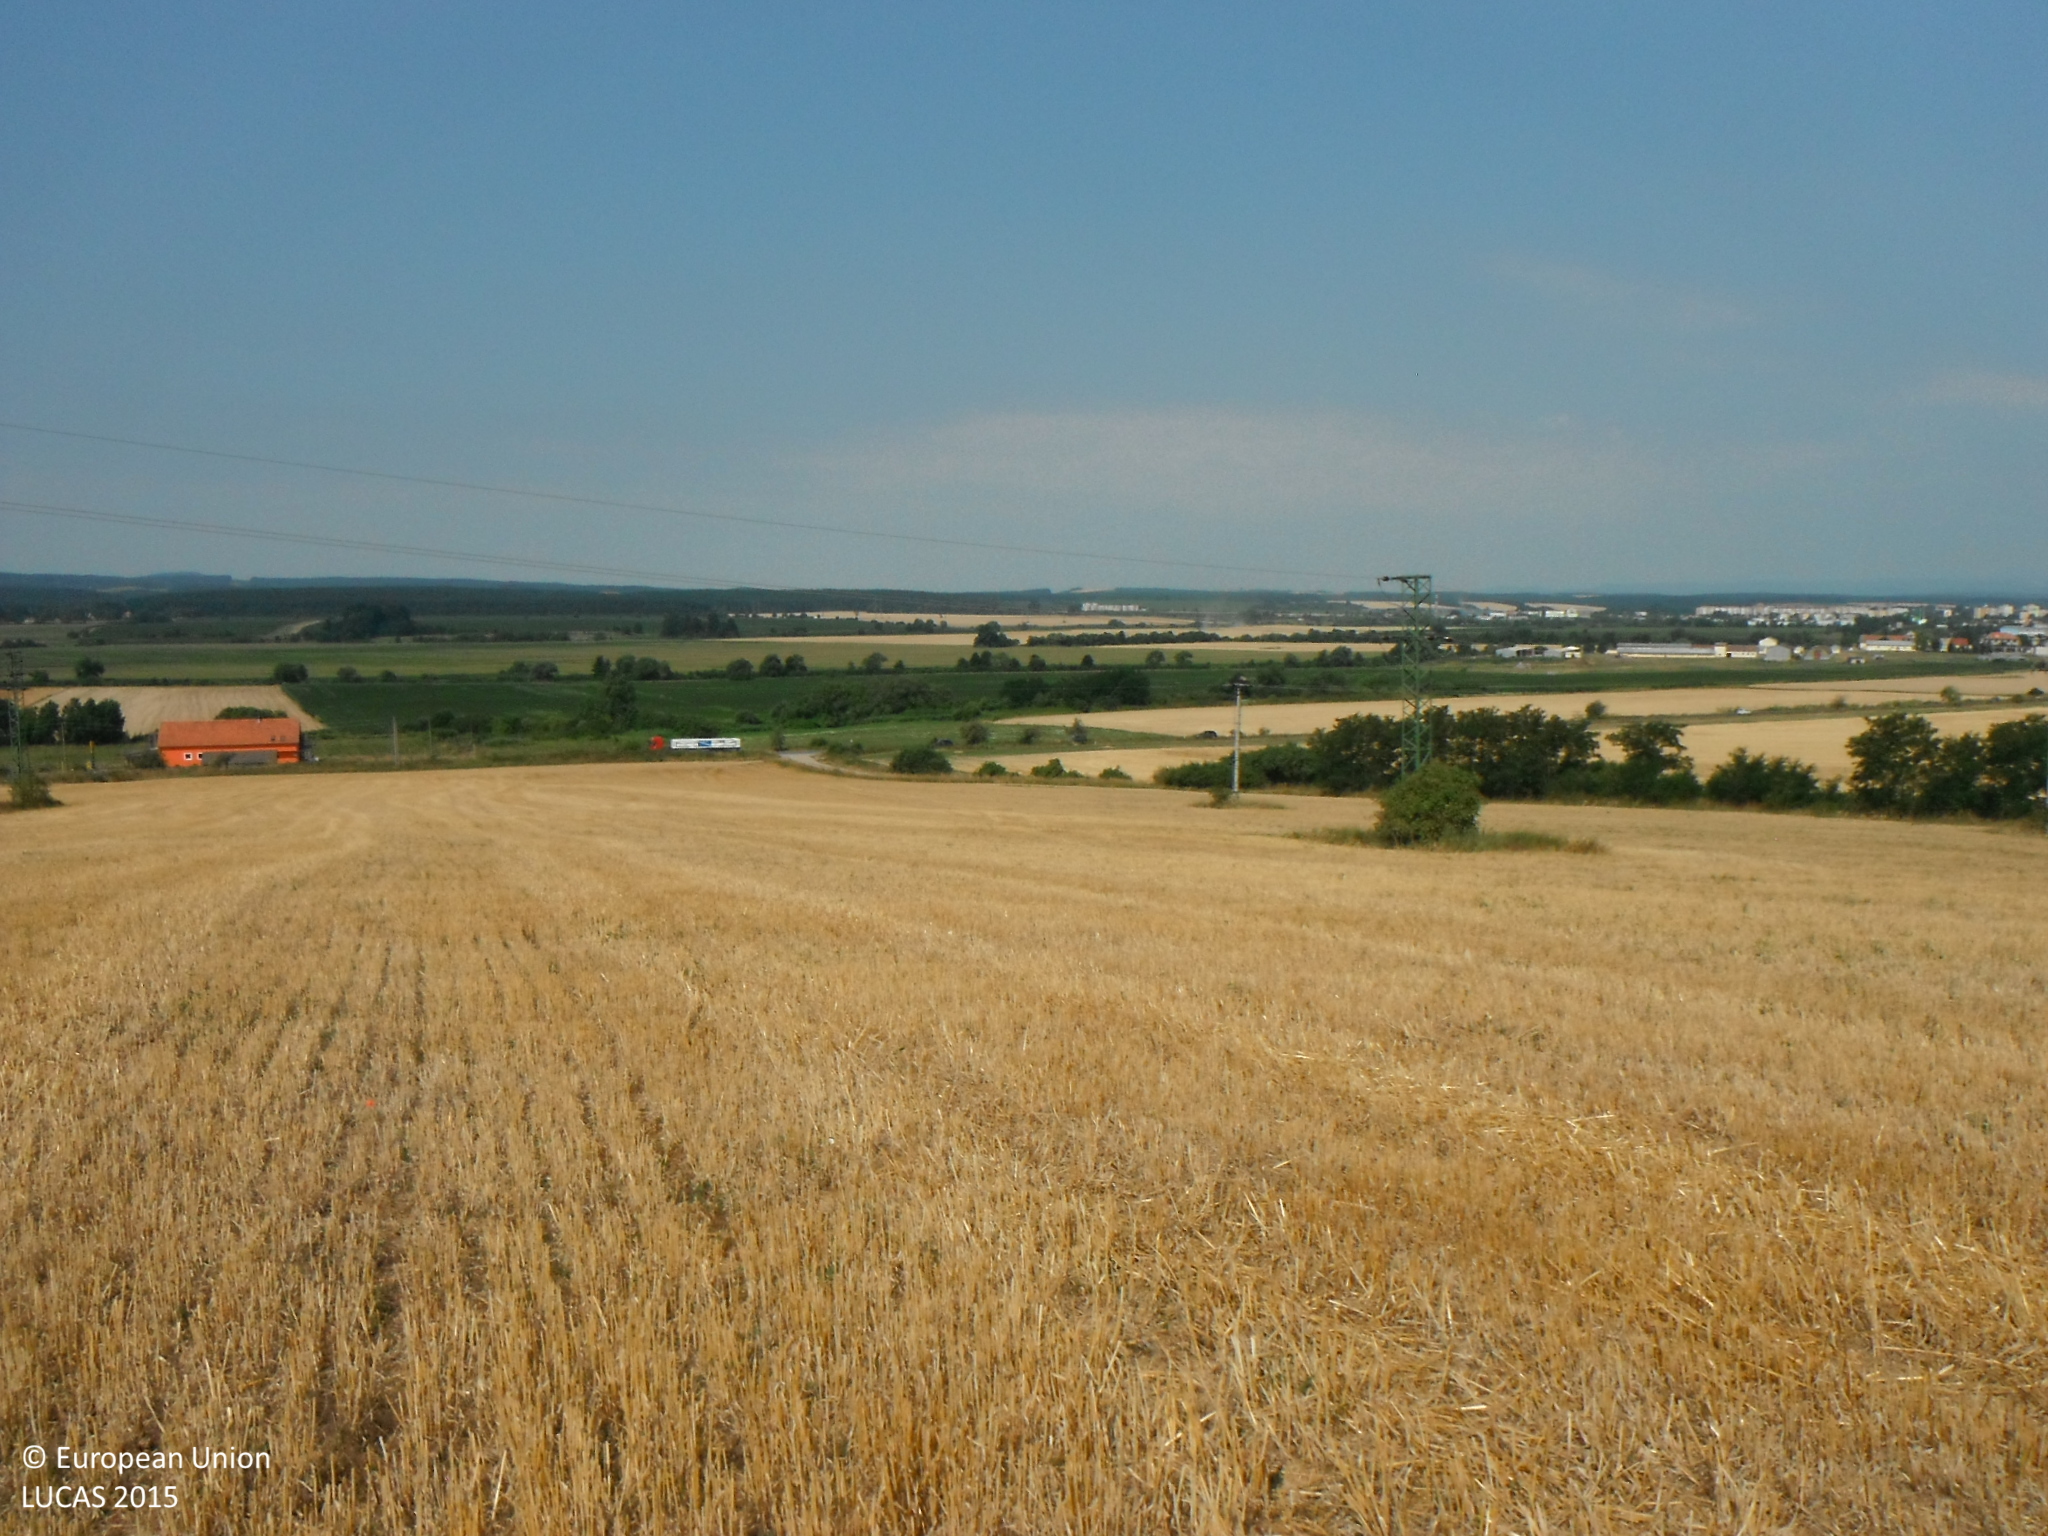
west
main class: Cropland
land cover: Barley
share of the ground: > 75 %
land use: Agriculture (excluding fallow land and kitchen gardens)
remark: Harvested field
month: July
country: SK
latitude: 48.3608
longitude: 20.0578
